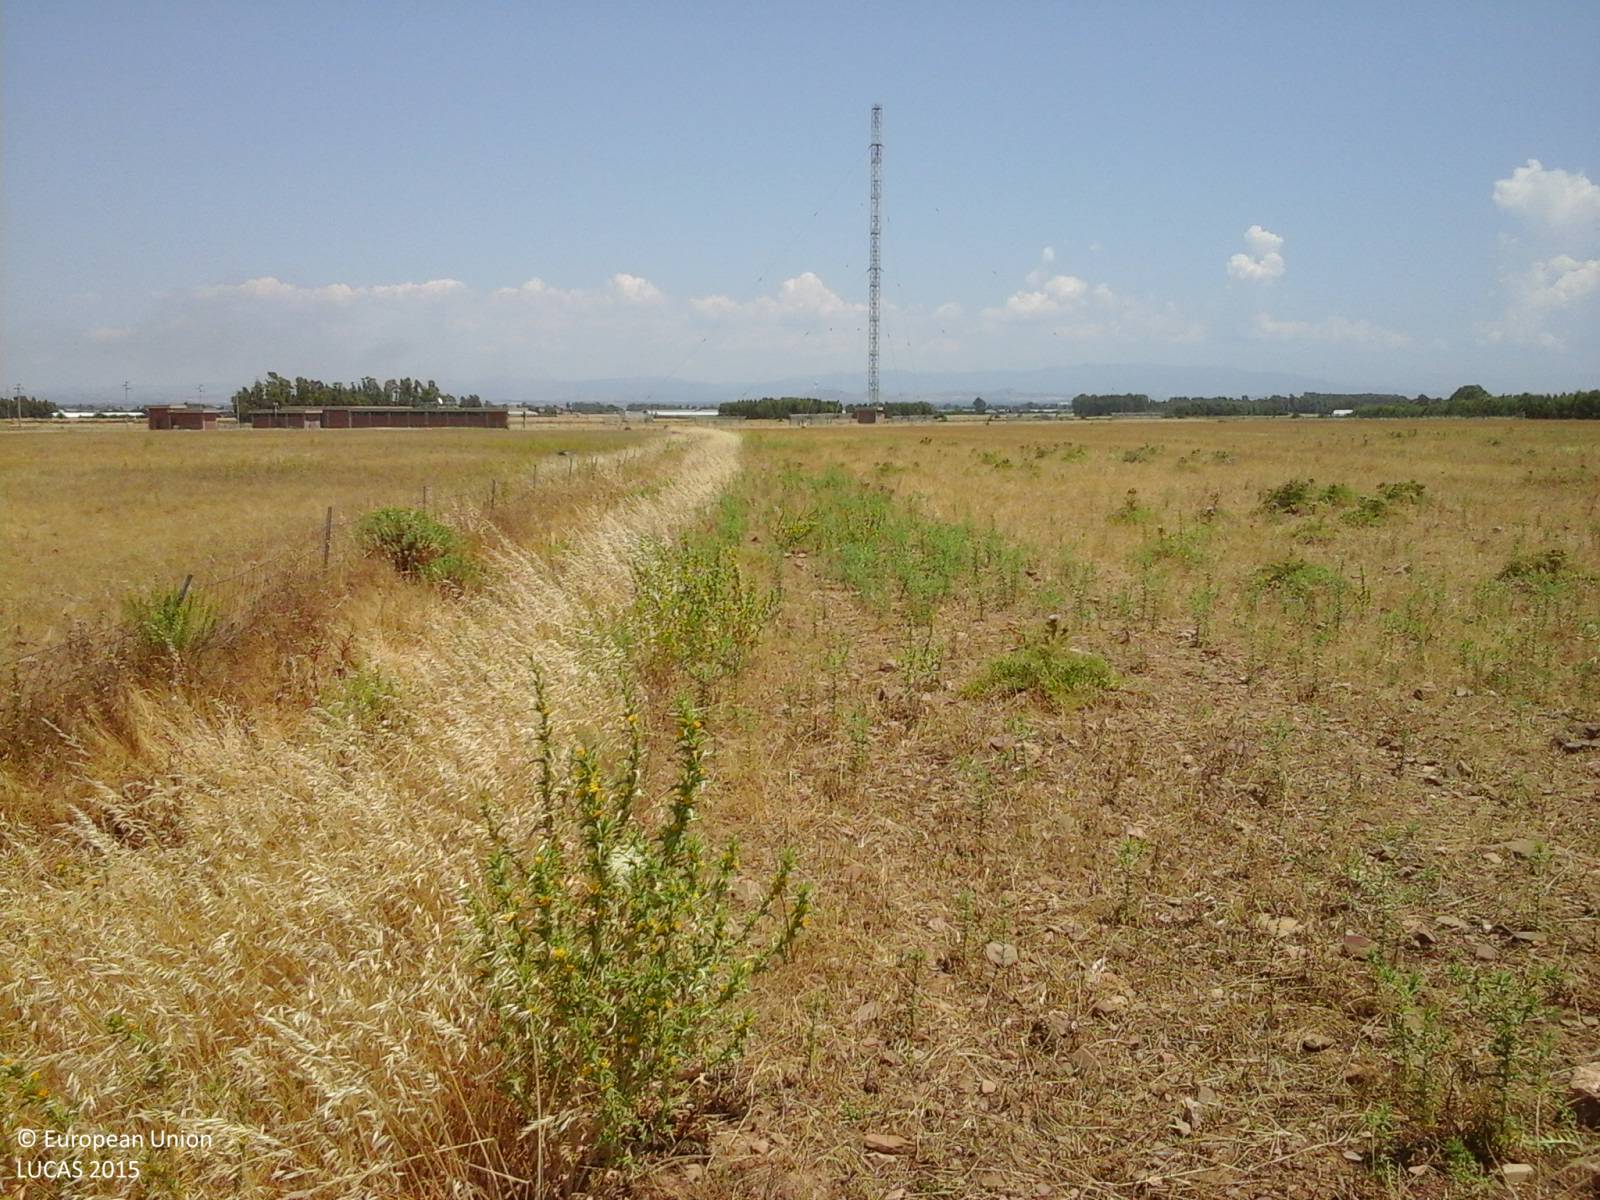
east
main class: Grassland
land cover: Spontaneously vegetated surfaces
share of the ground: > 75 %
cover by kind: herbaceous plants 85 %, unconsolidated bare surface 15 %
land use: Agriculture (excluding fallow land and kitchen gardens)
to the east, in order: Spontaneously vegetated surfaces
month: June
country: IT
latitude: 39.3369
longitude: 8.8584
